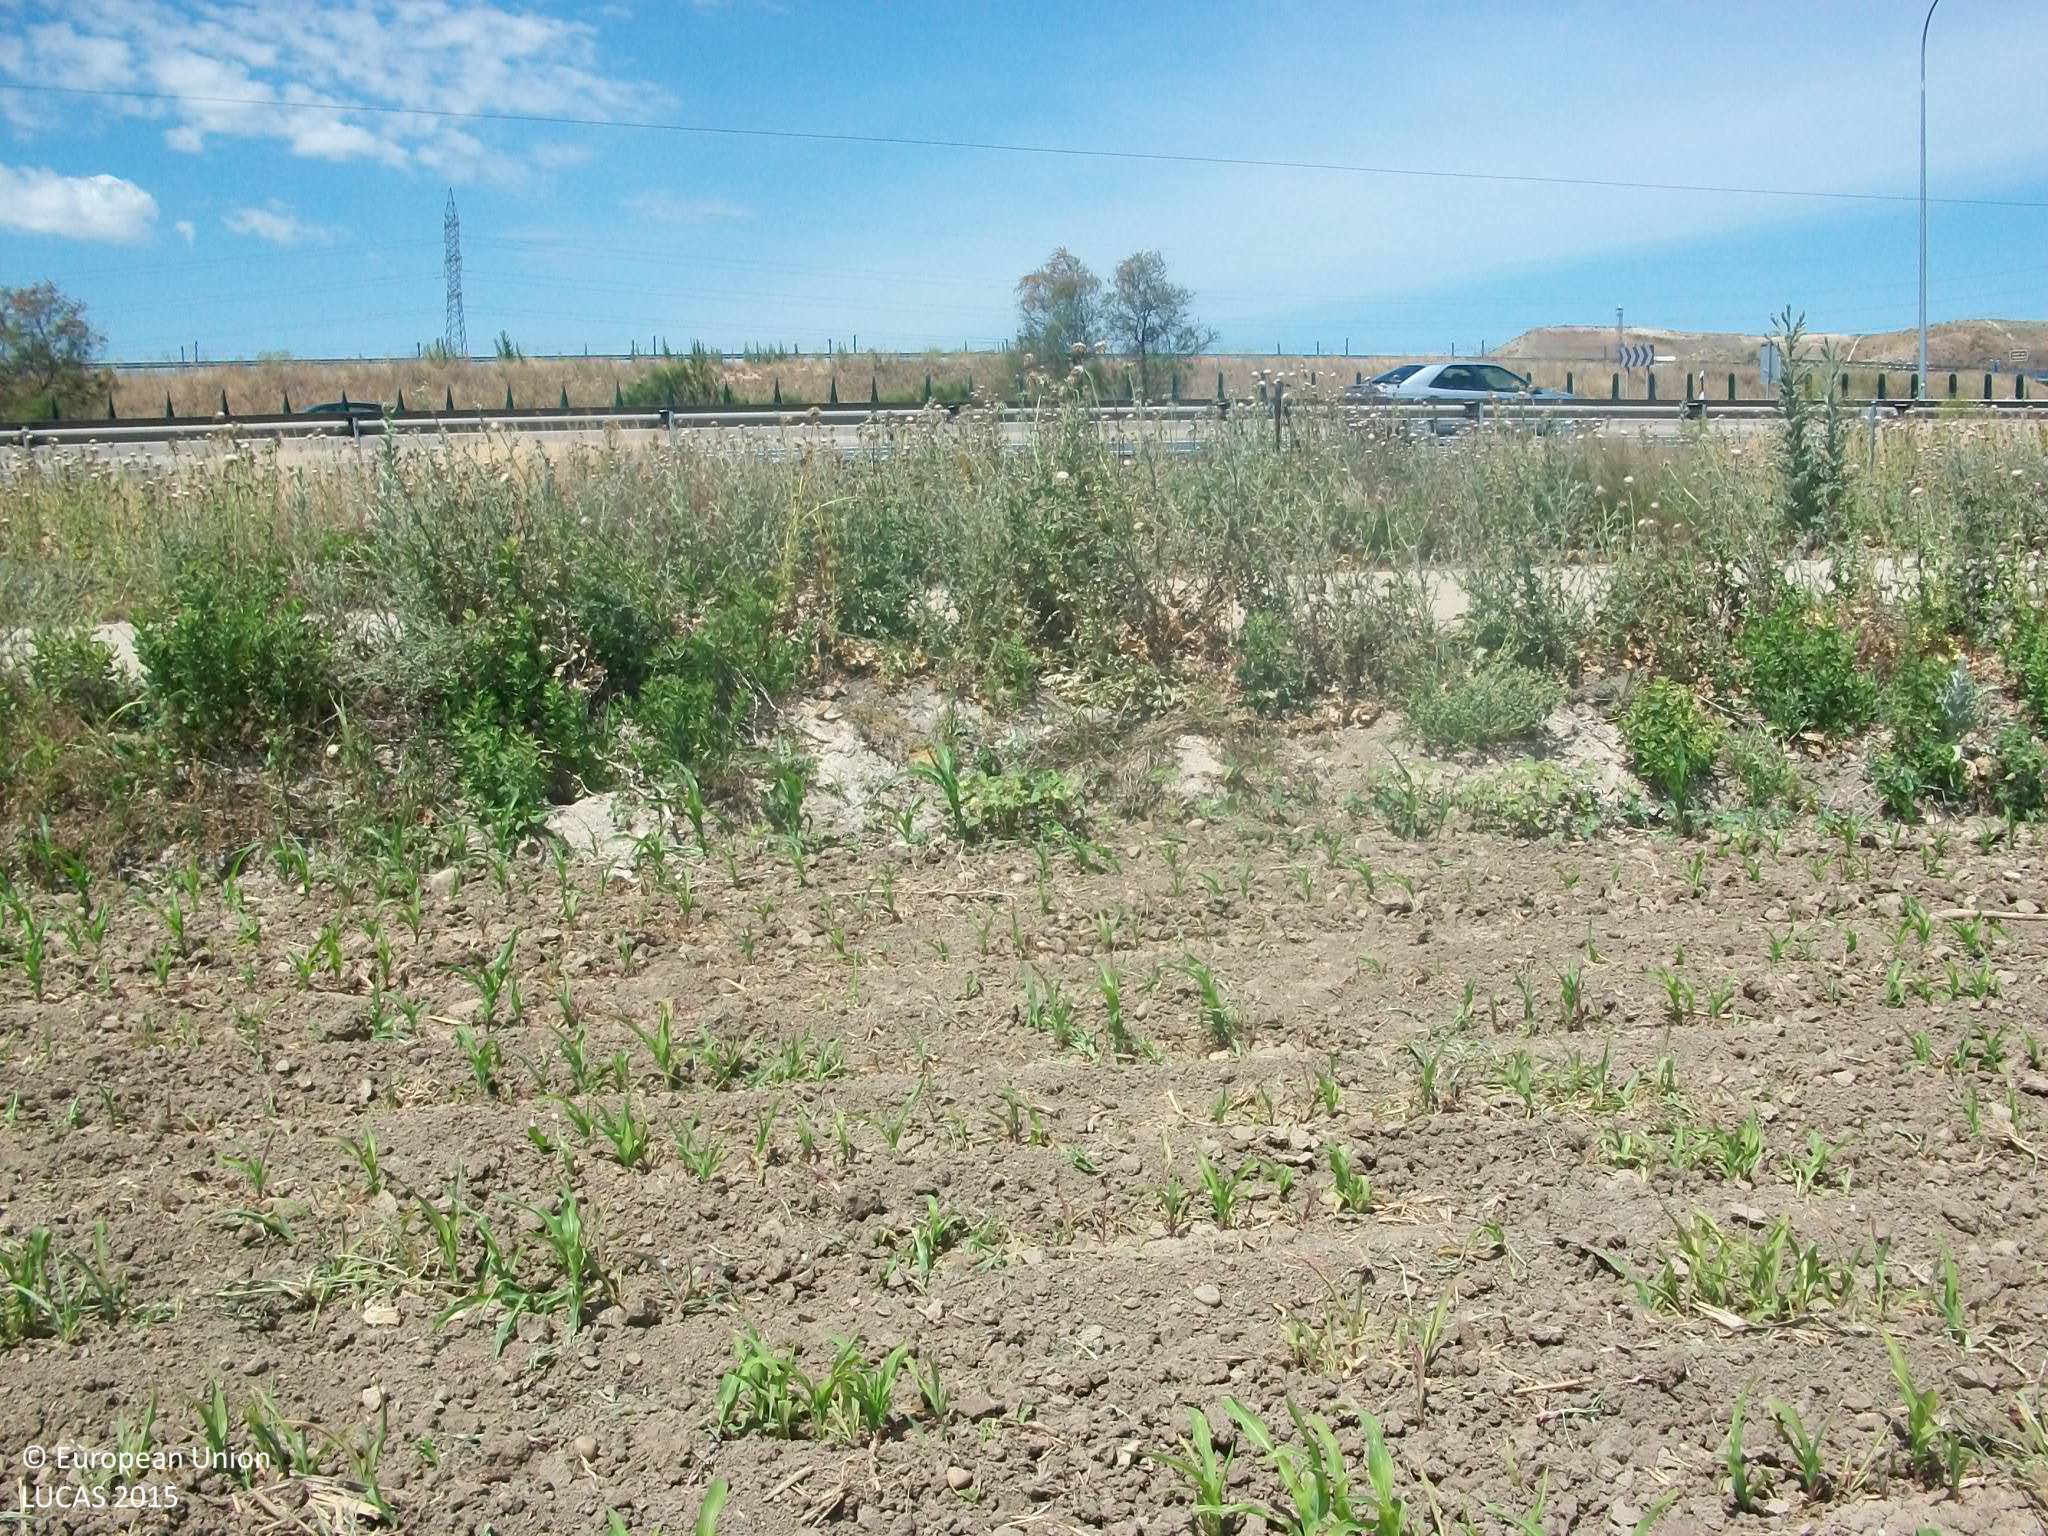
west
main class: Cropland
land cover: Maize
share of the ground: 50 - 75 %
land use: Agriculture (excluding fallow land and kitchen gardens)
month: May
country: ES
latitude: 40.0394
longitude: -3.6624
